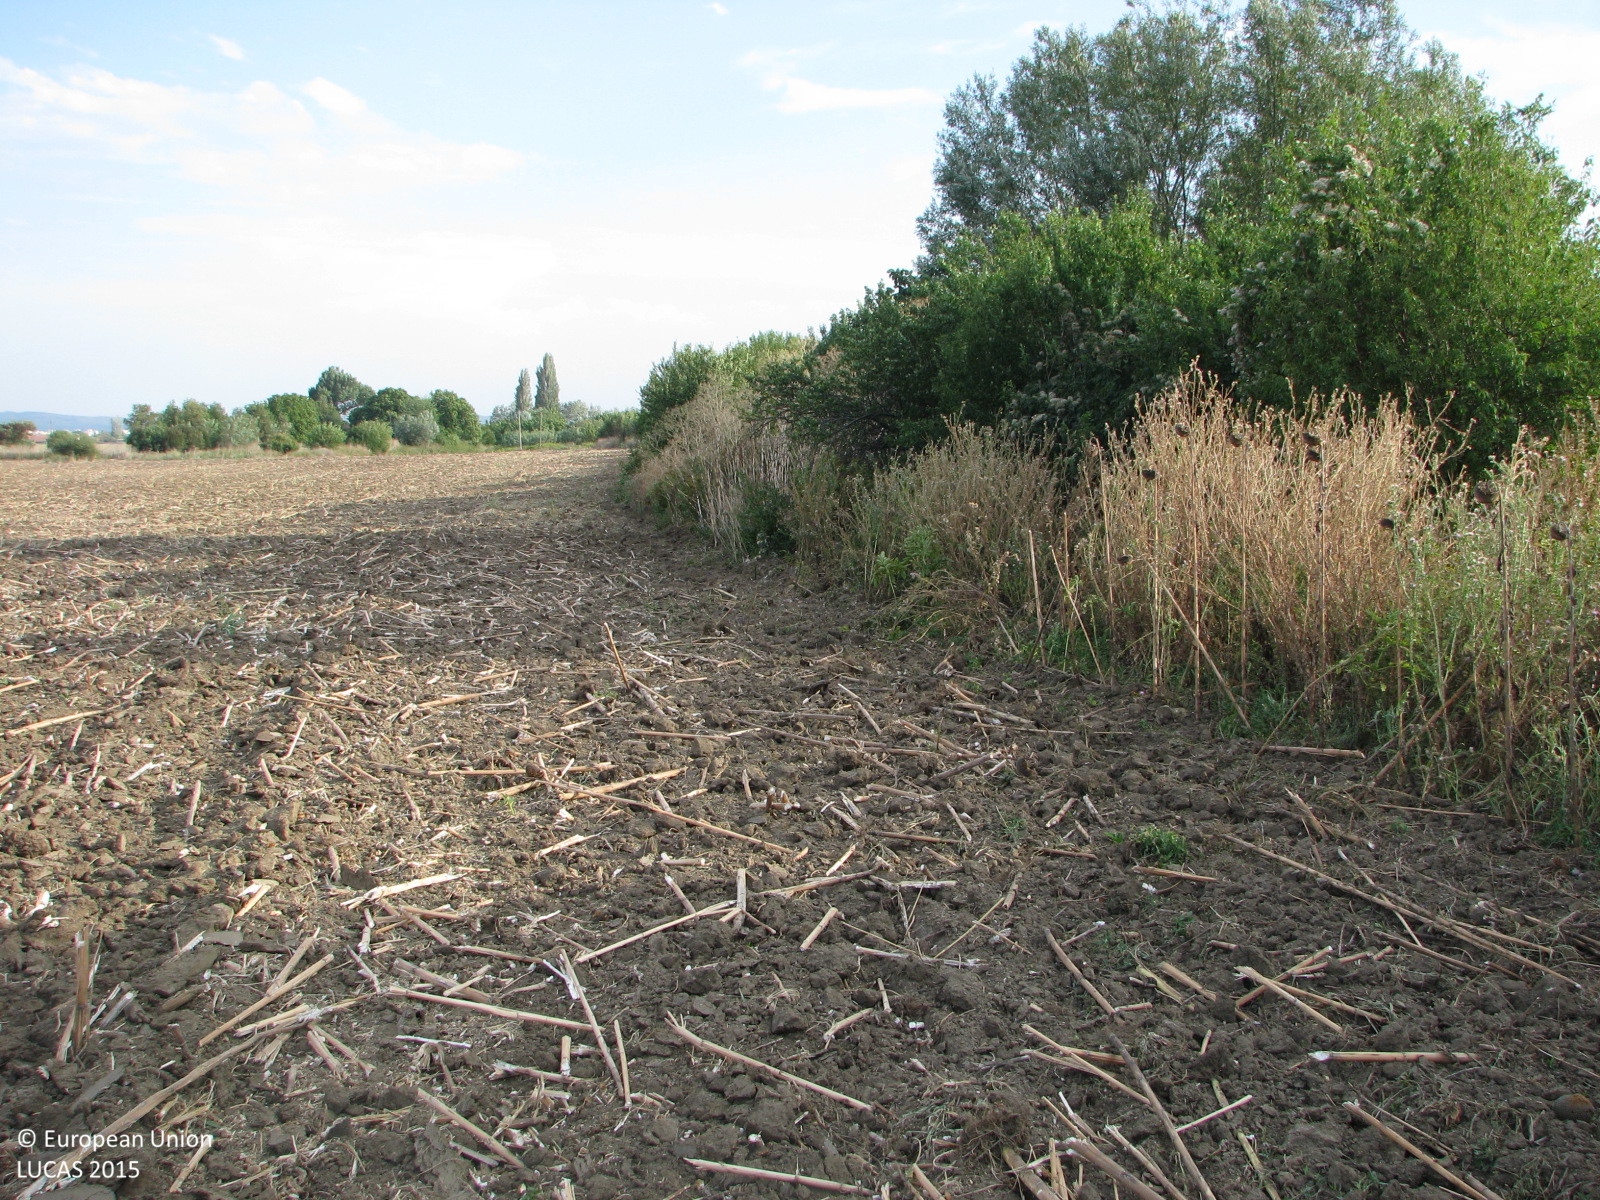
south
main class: Cropland
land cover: Sunflower
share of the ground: < 10 %
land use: Agriculture (excluding fallow land and kitchen gardens)
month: September
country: BG
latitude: 42.5135
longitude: 25.9884
